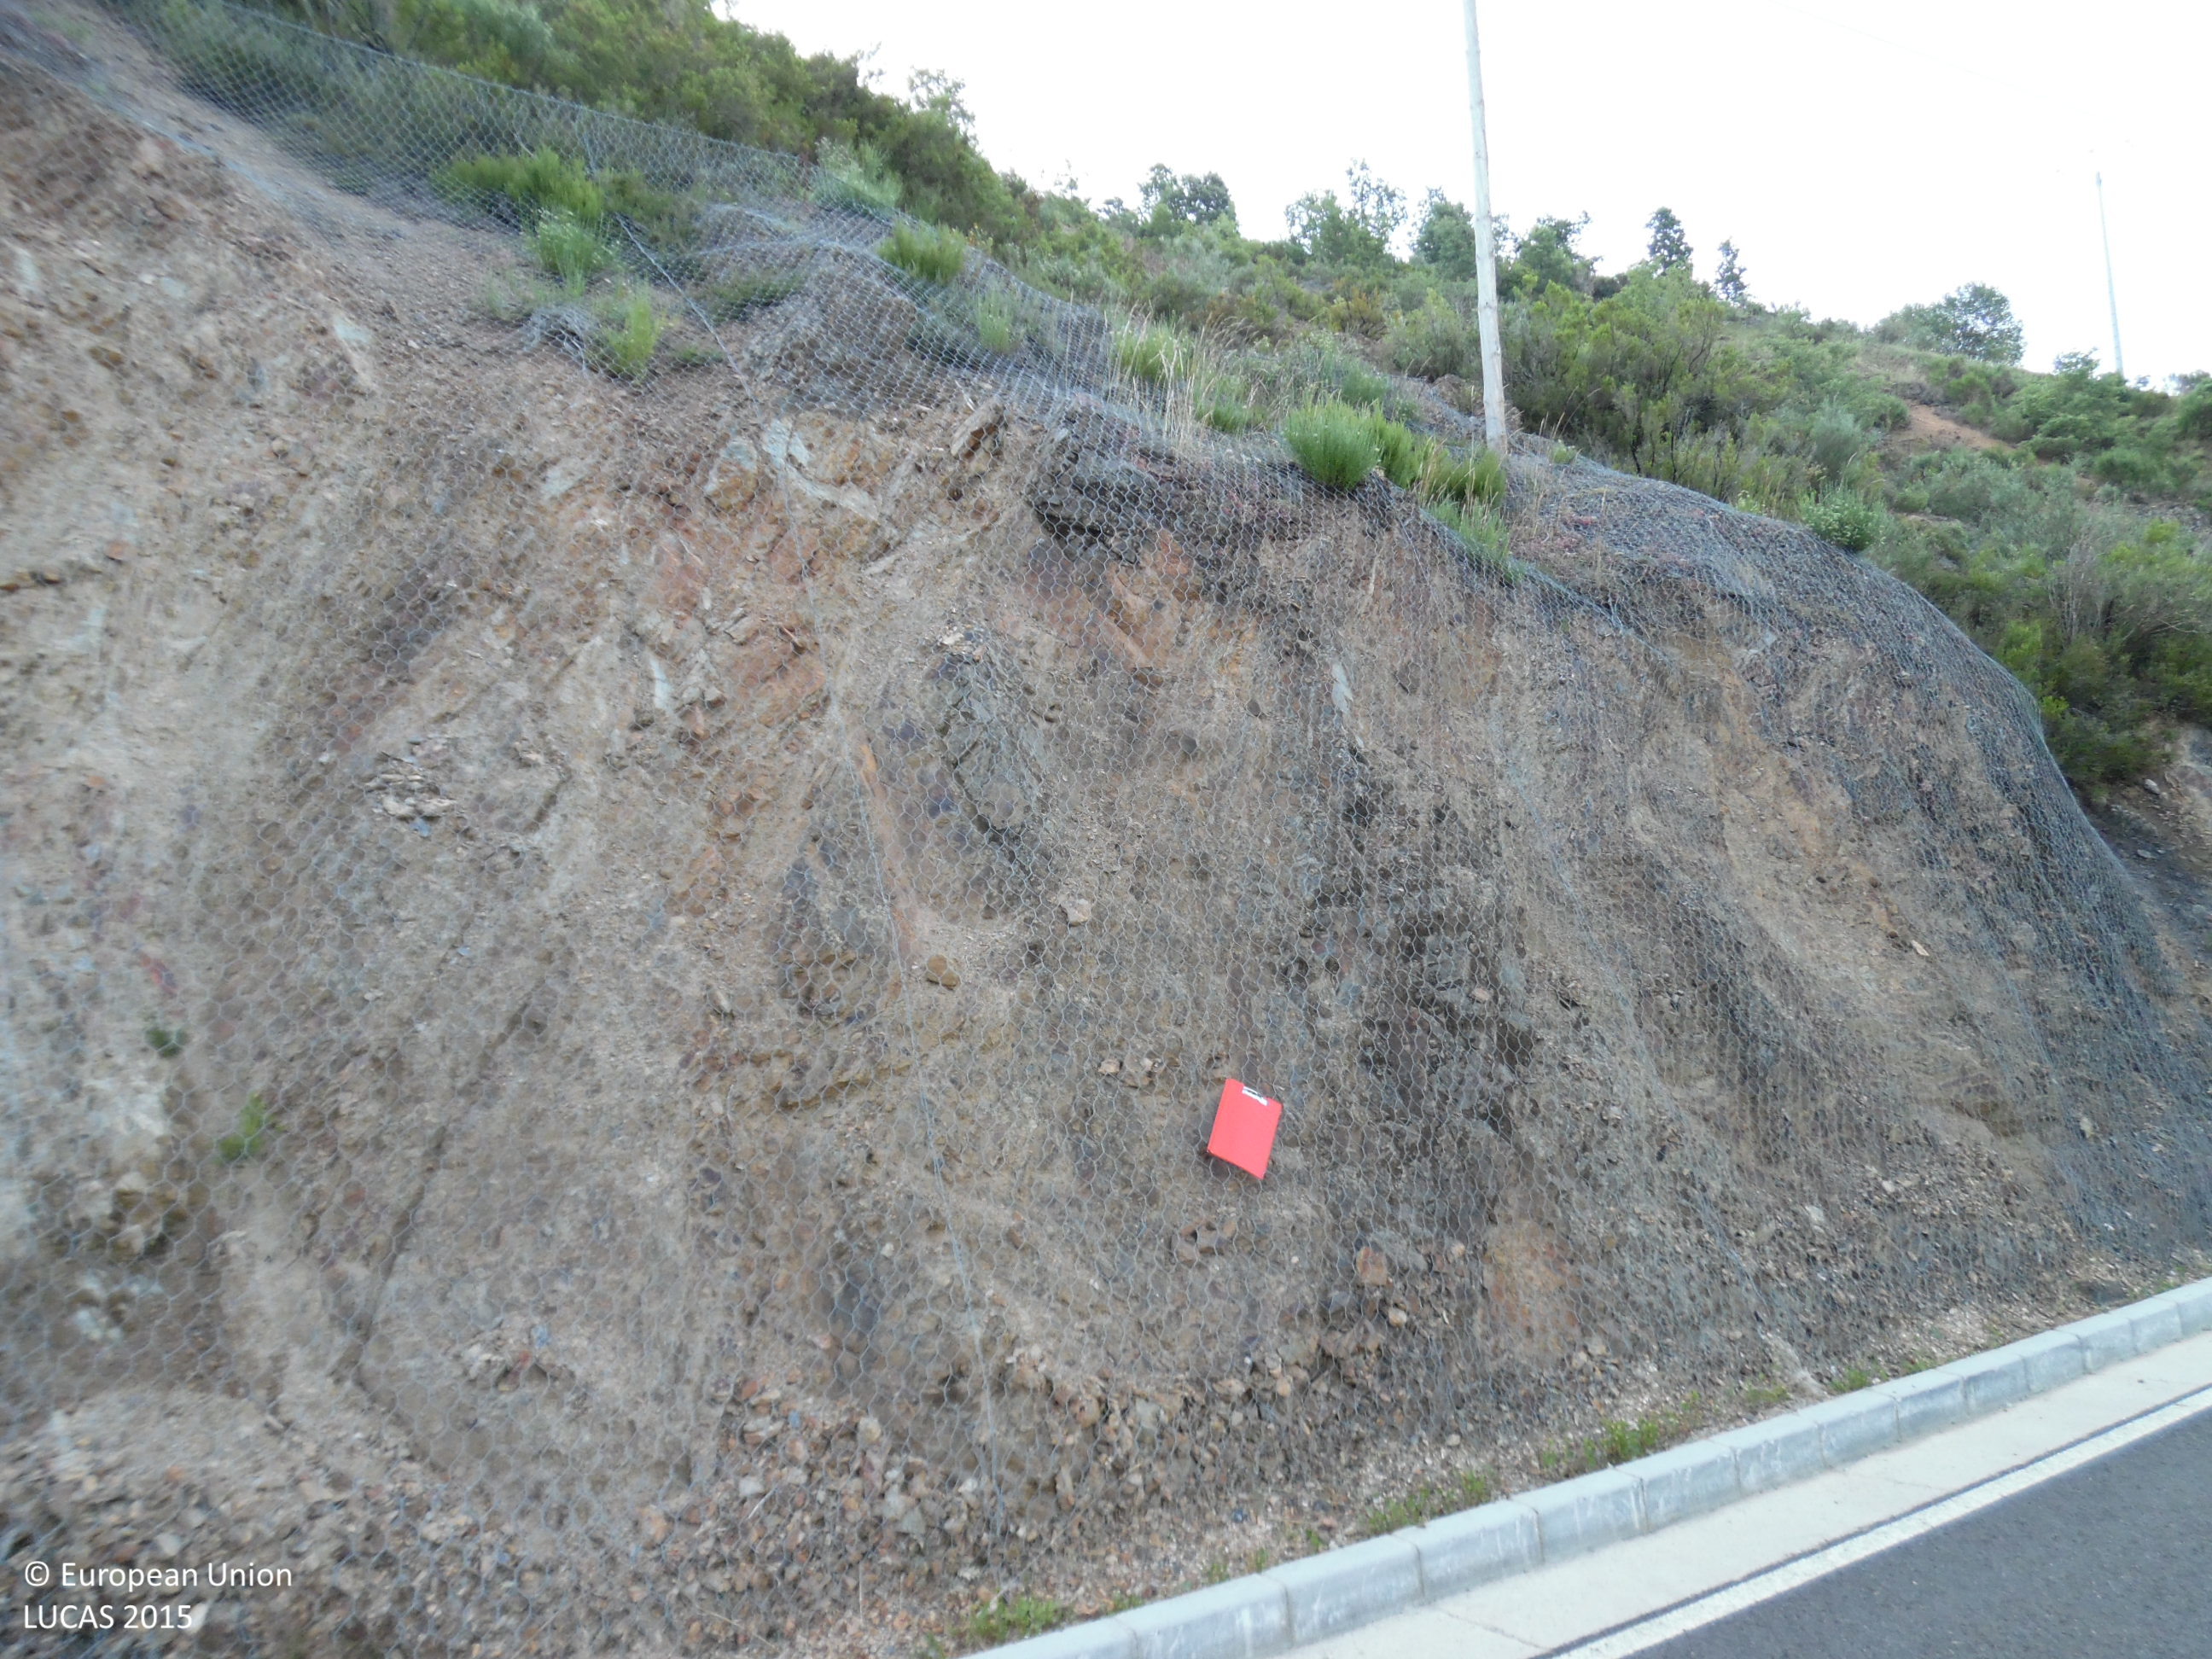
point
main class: Shrubland
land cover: Shrubland with sparse tree cover
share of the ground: > 75 %
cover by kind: shrubs 85 %, unconsolidated bare surface 10 %, broadleaved forest trees 5 %
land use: Abandoned areas
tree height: < 5 m
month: June
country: ES
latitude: 42.8054
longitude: -5.7683
